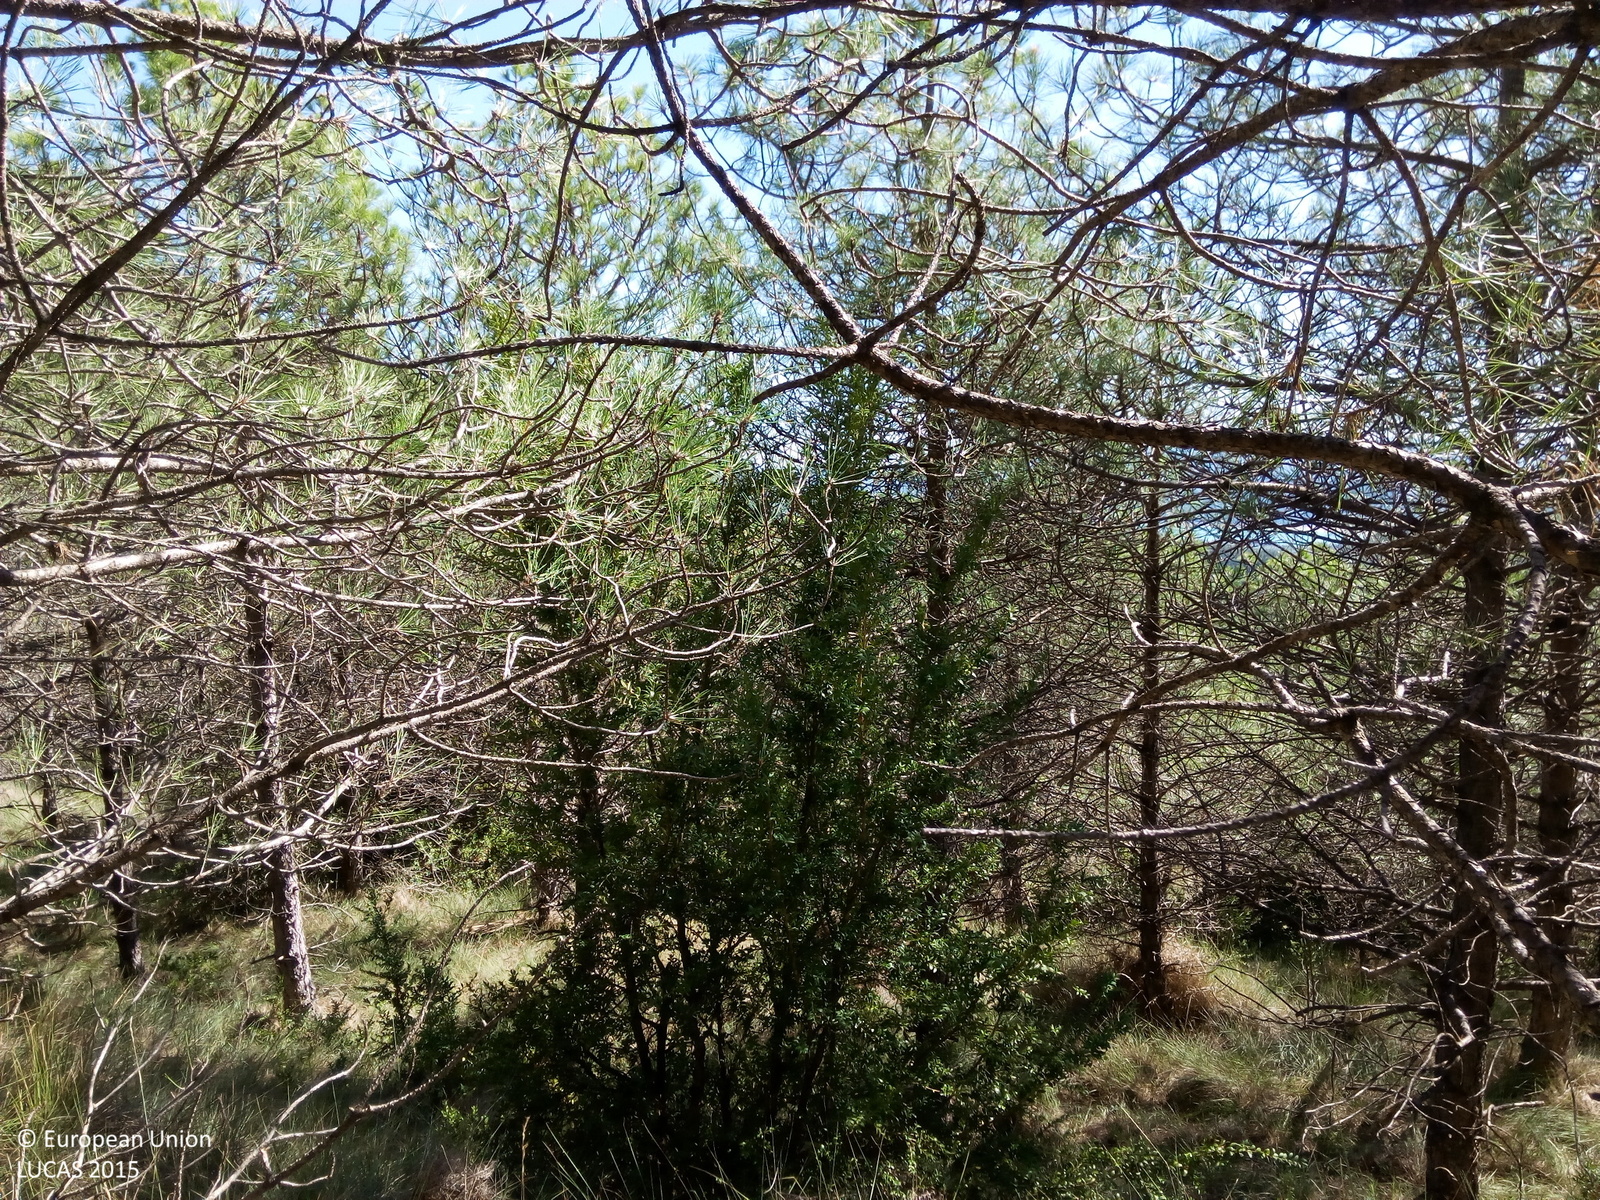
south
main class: Woodland
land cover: Pine dominated coniferous woodland
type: alpine coniferous forest
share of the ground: > 75 %
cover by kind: coniferous forest trees 80 %, shrubs 20 %
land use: Forestry
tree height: > 5 m
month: August
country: ES
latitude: 42.4316
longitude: 0.1940
